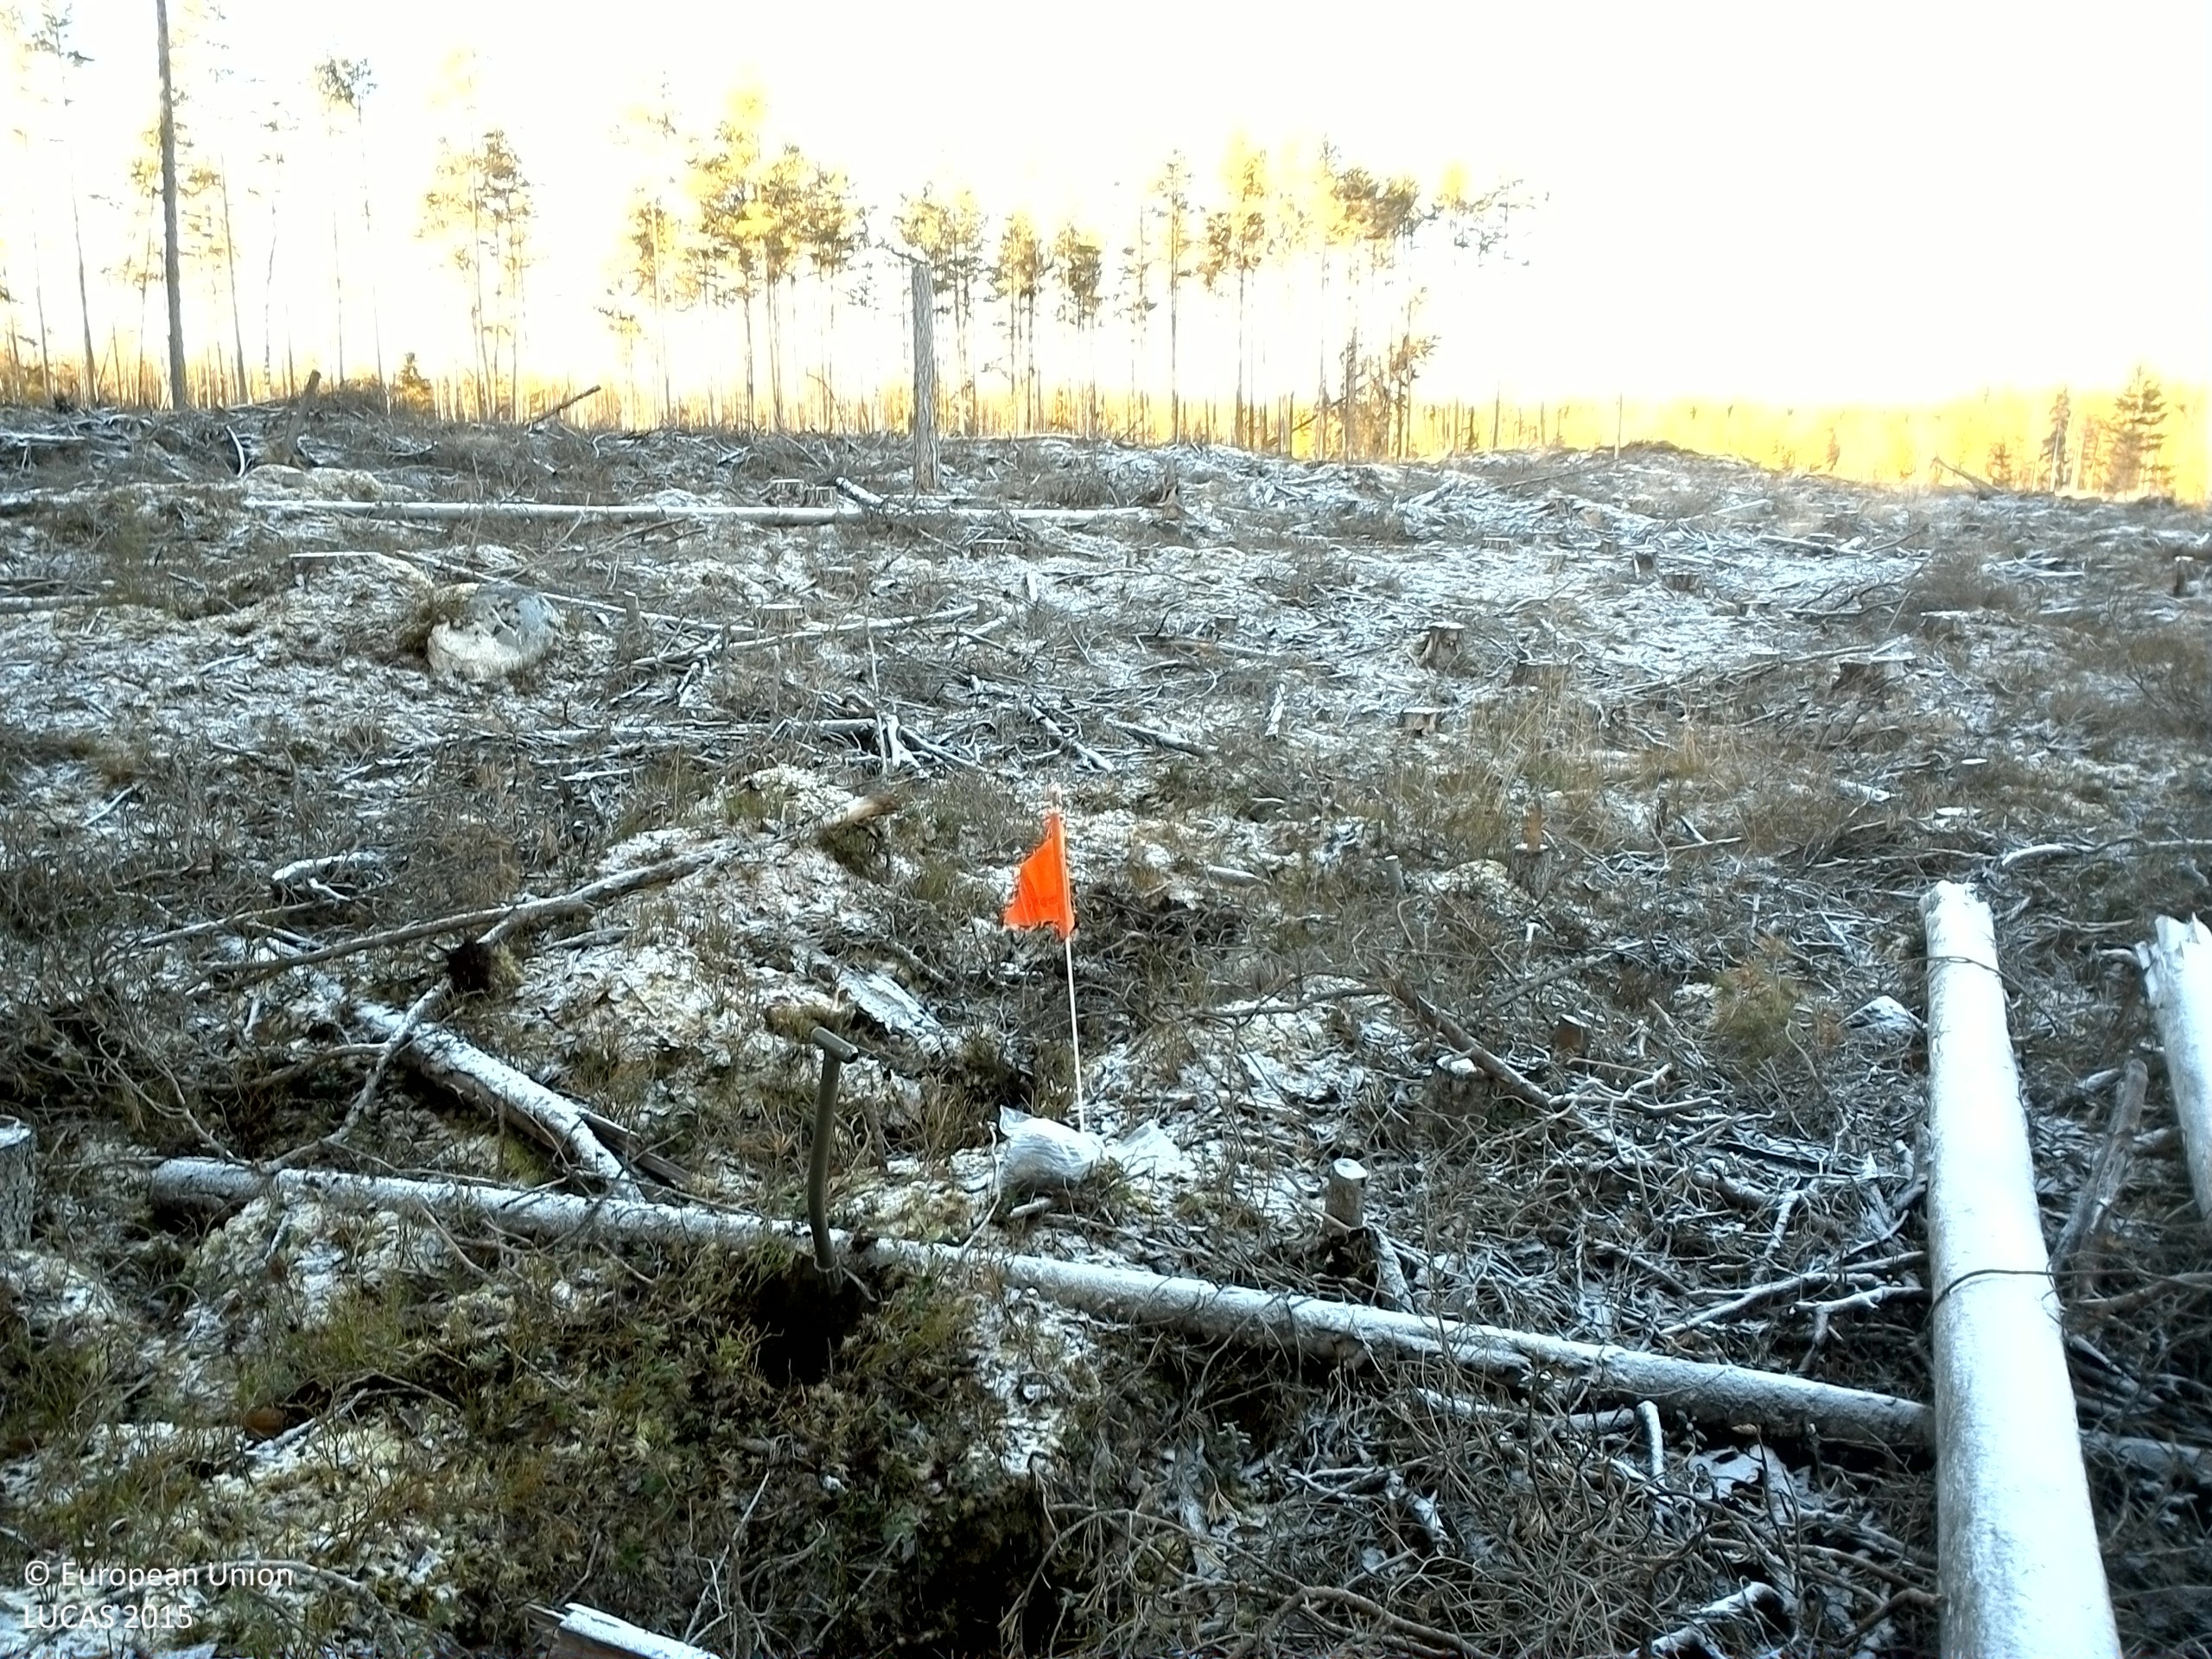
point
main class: Shrubland
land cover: Shrubland without tree cover
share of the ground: 25 - 50 %
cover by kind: shrubs 45 %, herbaceous plants 20 %, lichens and mosses 5 %
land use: Forestry
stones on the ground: < 10 %
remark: Clear cut
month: November
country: SE
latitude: 60.2396
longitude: 15.8586
